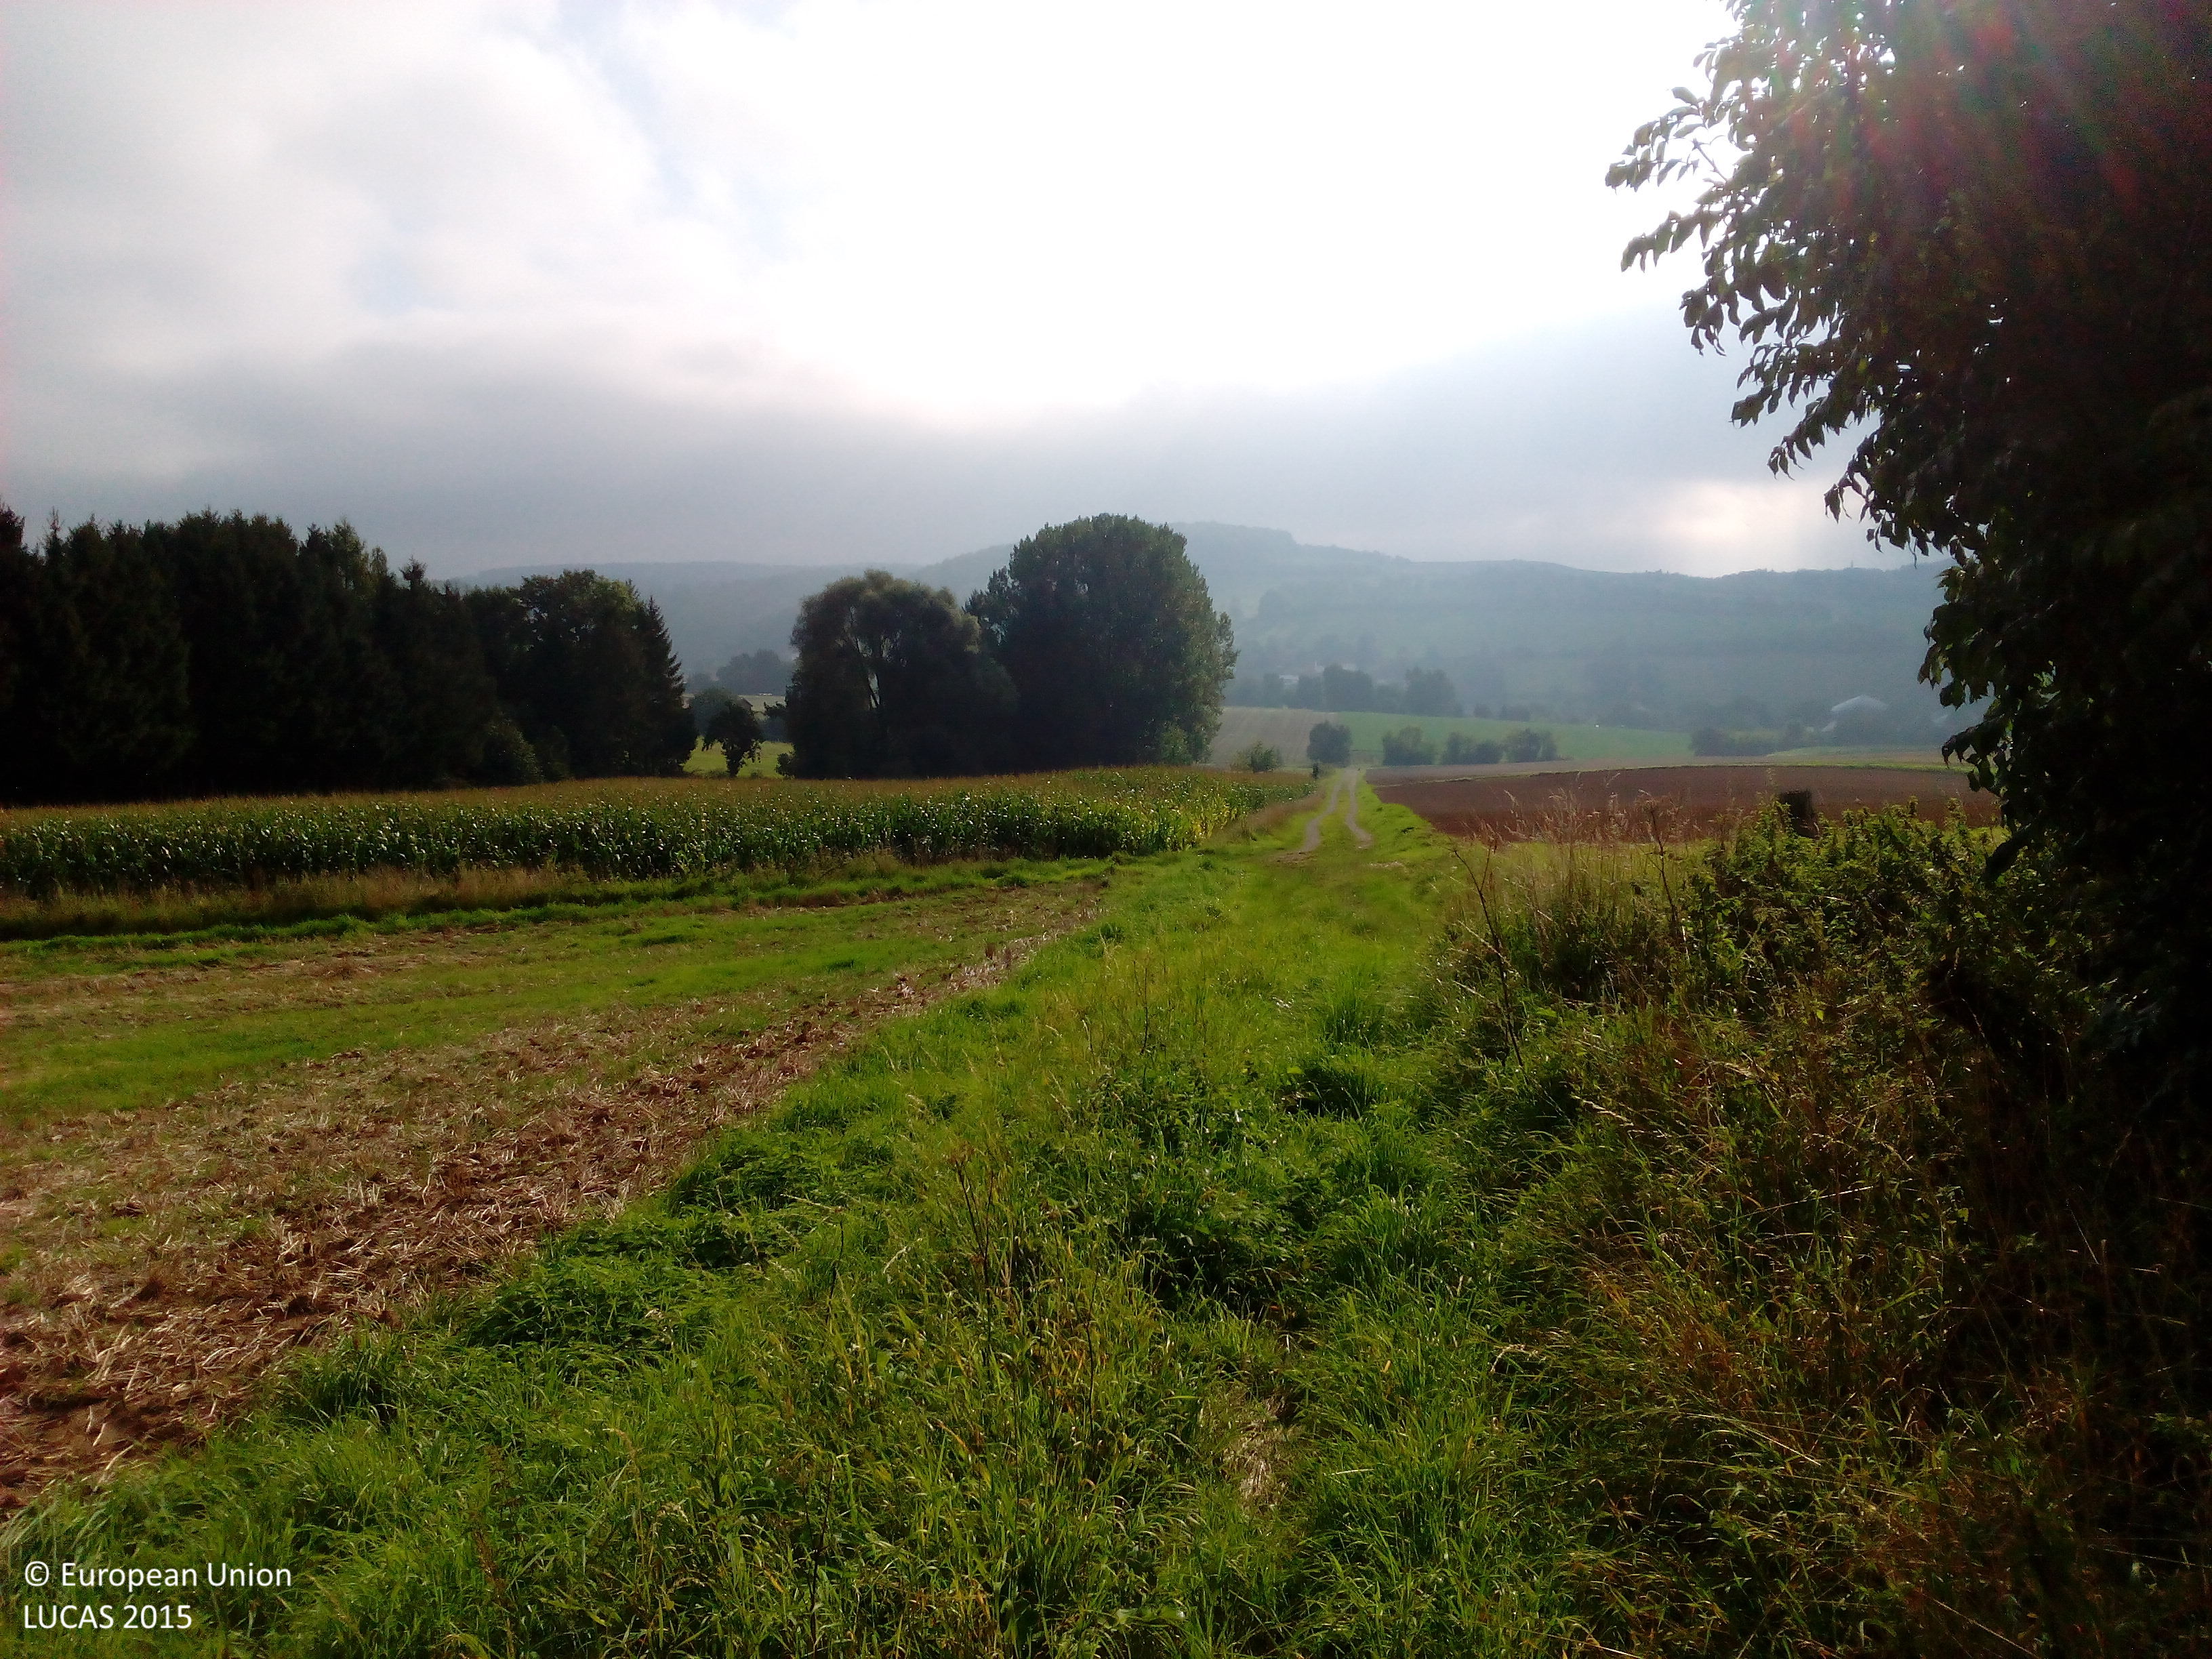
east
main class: Grassland
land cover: Grassland with sparse tree/shrub cover
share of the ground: > 75 %
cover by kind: herbaceous plants 90 %, broadleaved forest trees 5 %, shrubs 5 %
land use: Agriculture (excluding fallow land and kitchen gardens)
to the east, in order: Grassland with sparse tree/shrub cover; Fences; Grassland without tree/shrub cover; Fences; Common wheat; Other root crops; Grass margins; Tracks; Grass margins; Common wheat
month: September
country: DE
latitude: 51.4068
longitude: 9.9569
